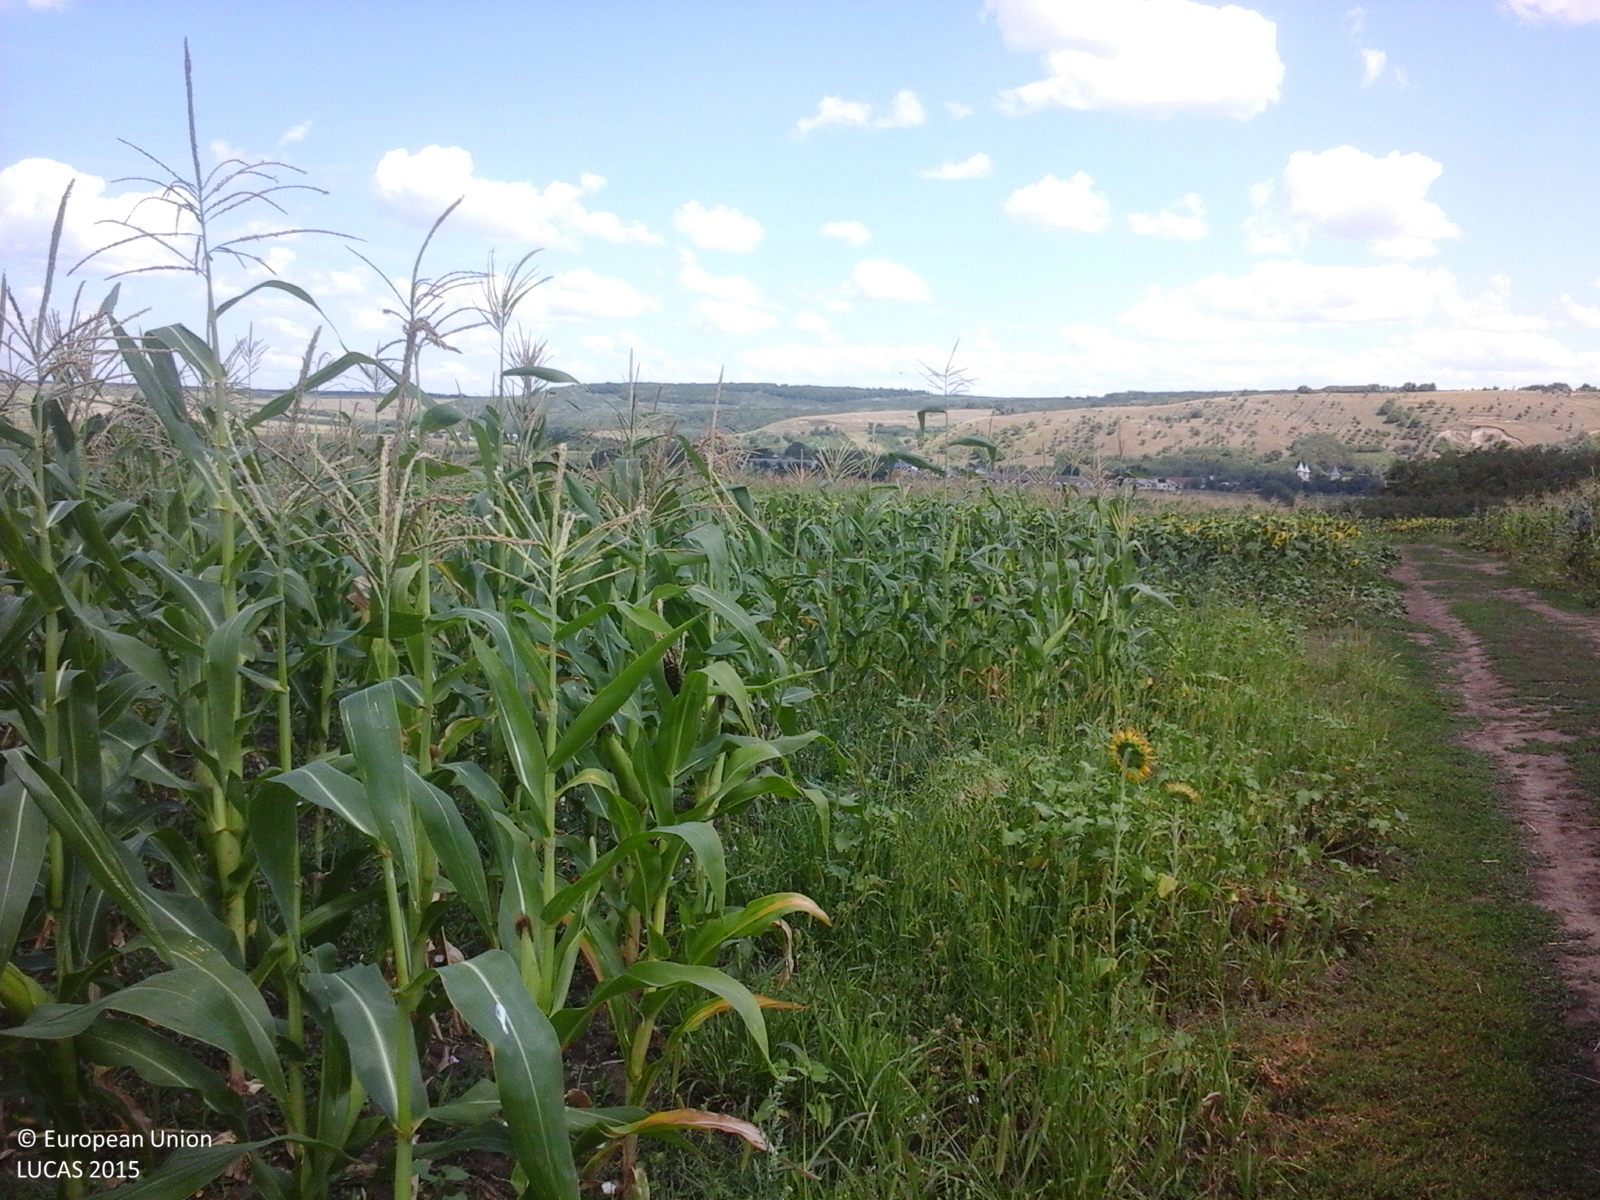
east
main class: Cropland
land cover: Maize
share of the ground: > 75 %
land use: Agriculture (excluding fallow land and kitchen gardens)
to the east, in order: Maize; Sunflower; Maize; Grass margins; Tracks; Grassland without tree/shrub cover
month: July
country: RO
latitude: 46.4486
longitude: 27.8921
